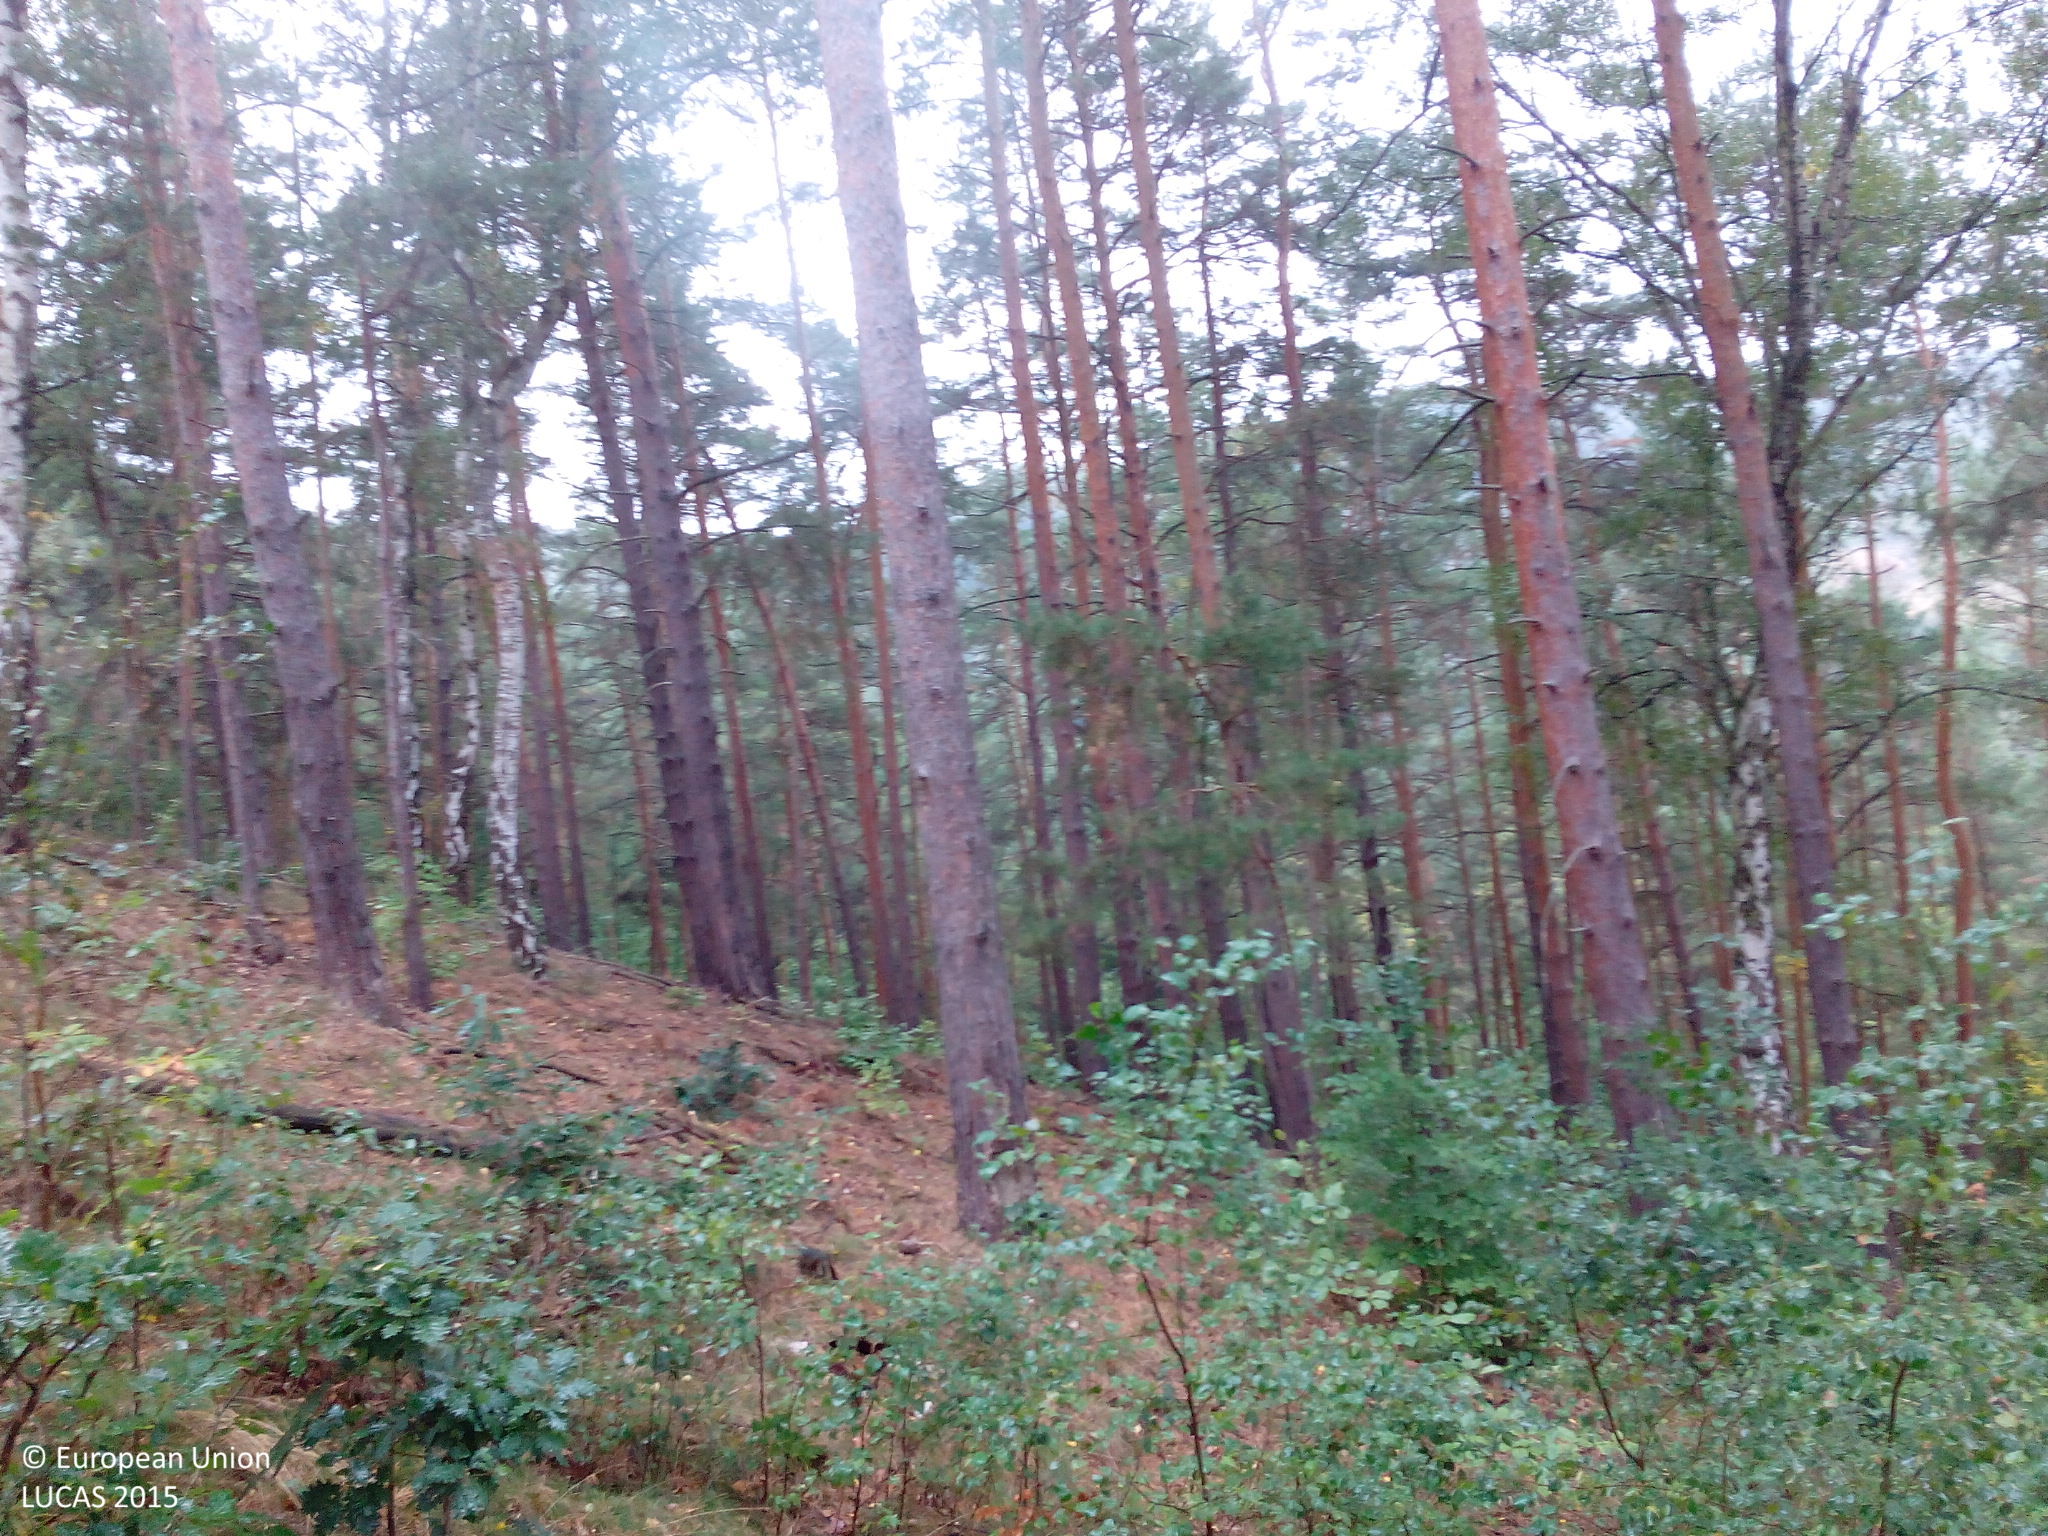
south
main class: Woodland
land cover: Pine dominated mixed woodland
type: hemiboreal forest and nemoral coniferous forest and mixed broadleaved-coniferous forest
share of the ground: > 75 %
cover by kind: coniferous forest trees 75 %, broadleaved forest trees 25 %
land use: Forestry
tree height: > 5 m
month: September
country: DE
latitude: 51.4203
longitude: 11.0207
